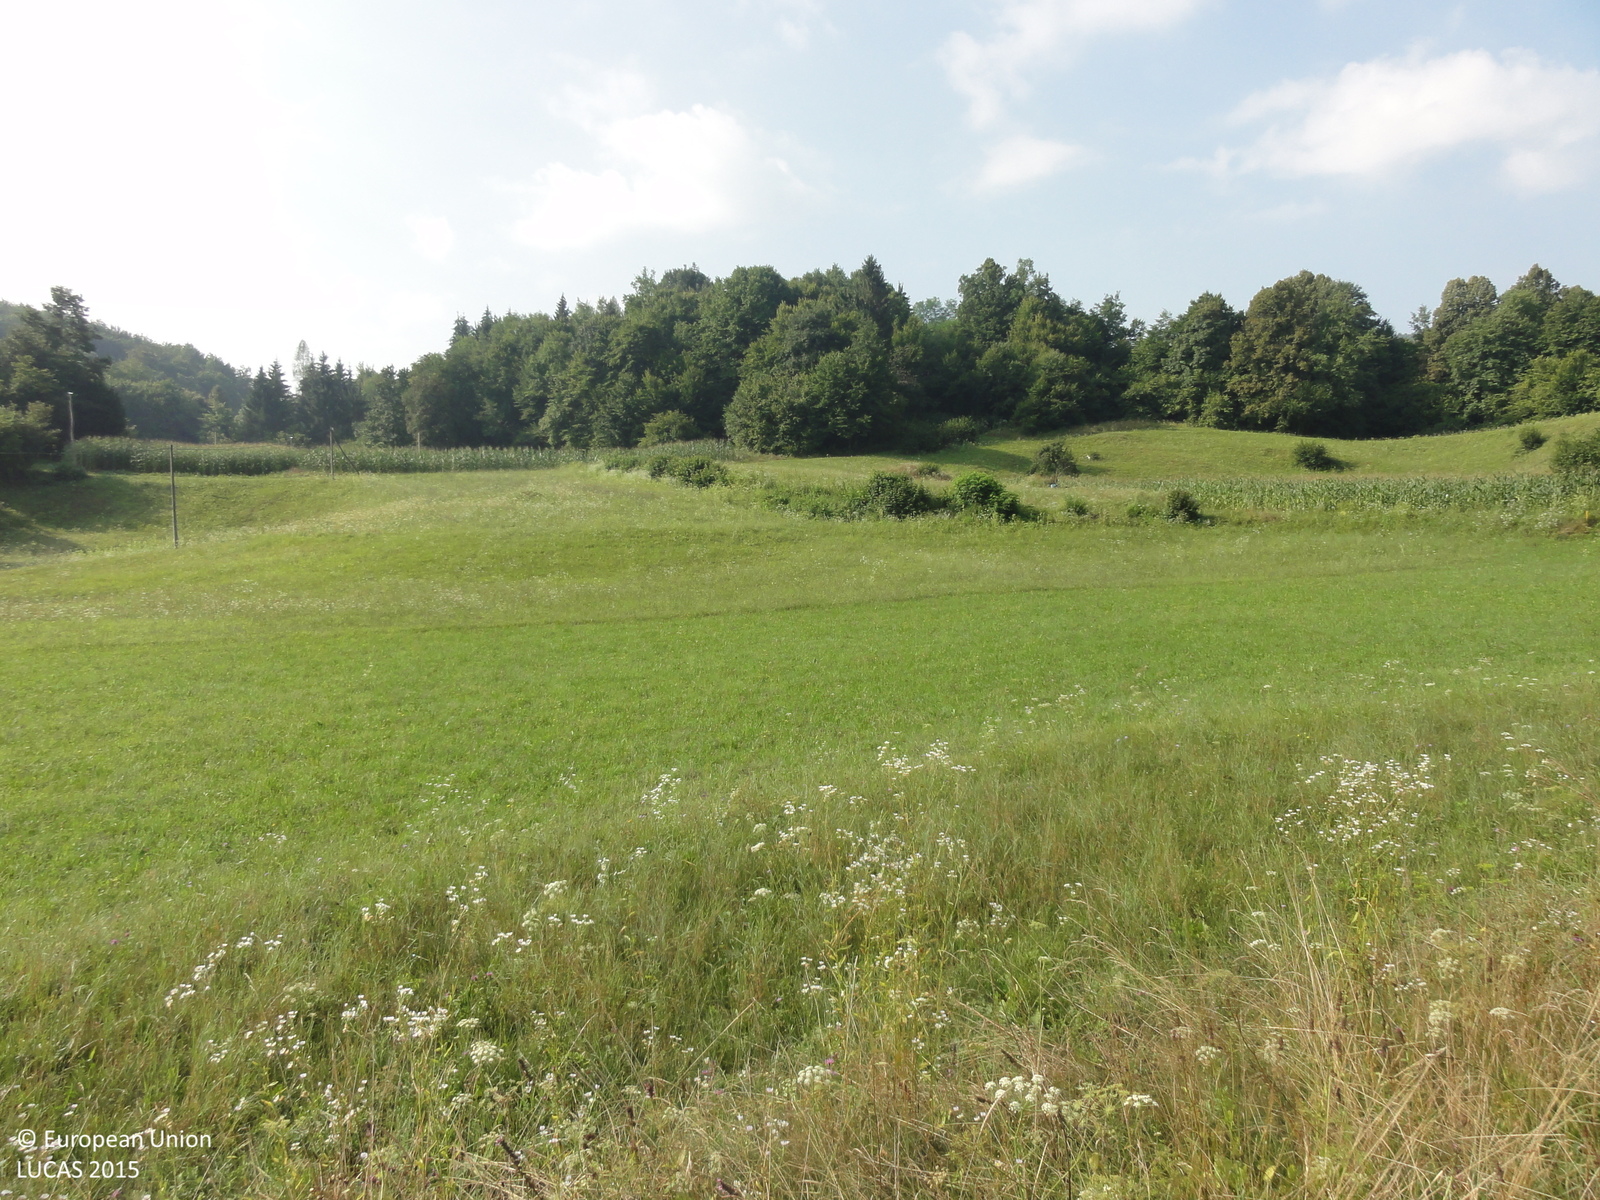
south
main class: Grassland
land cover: Grassland without tree/shrub cover
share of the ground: > 75 %
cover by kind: herbaceous plants 100 %
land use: Agriculture (excluding fallow land and kitchen gardens)
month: August
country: SI
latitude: 45.8811
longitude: 15.2151
